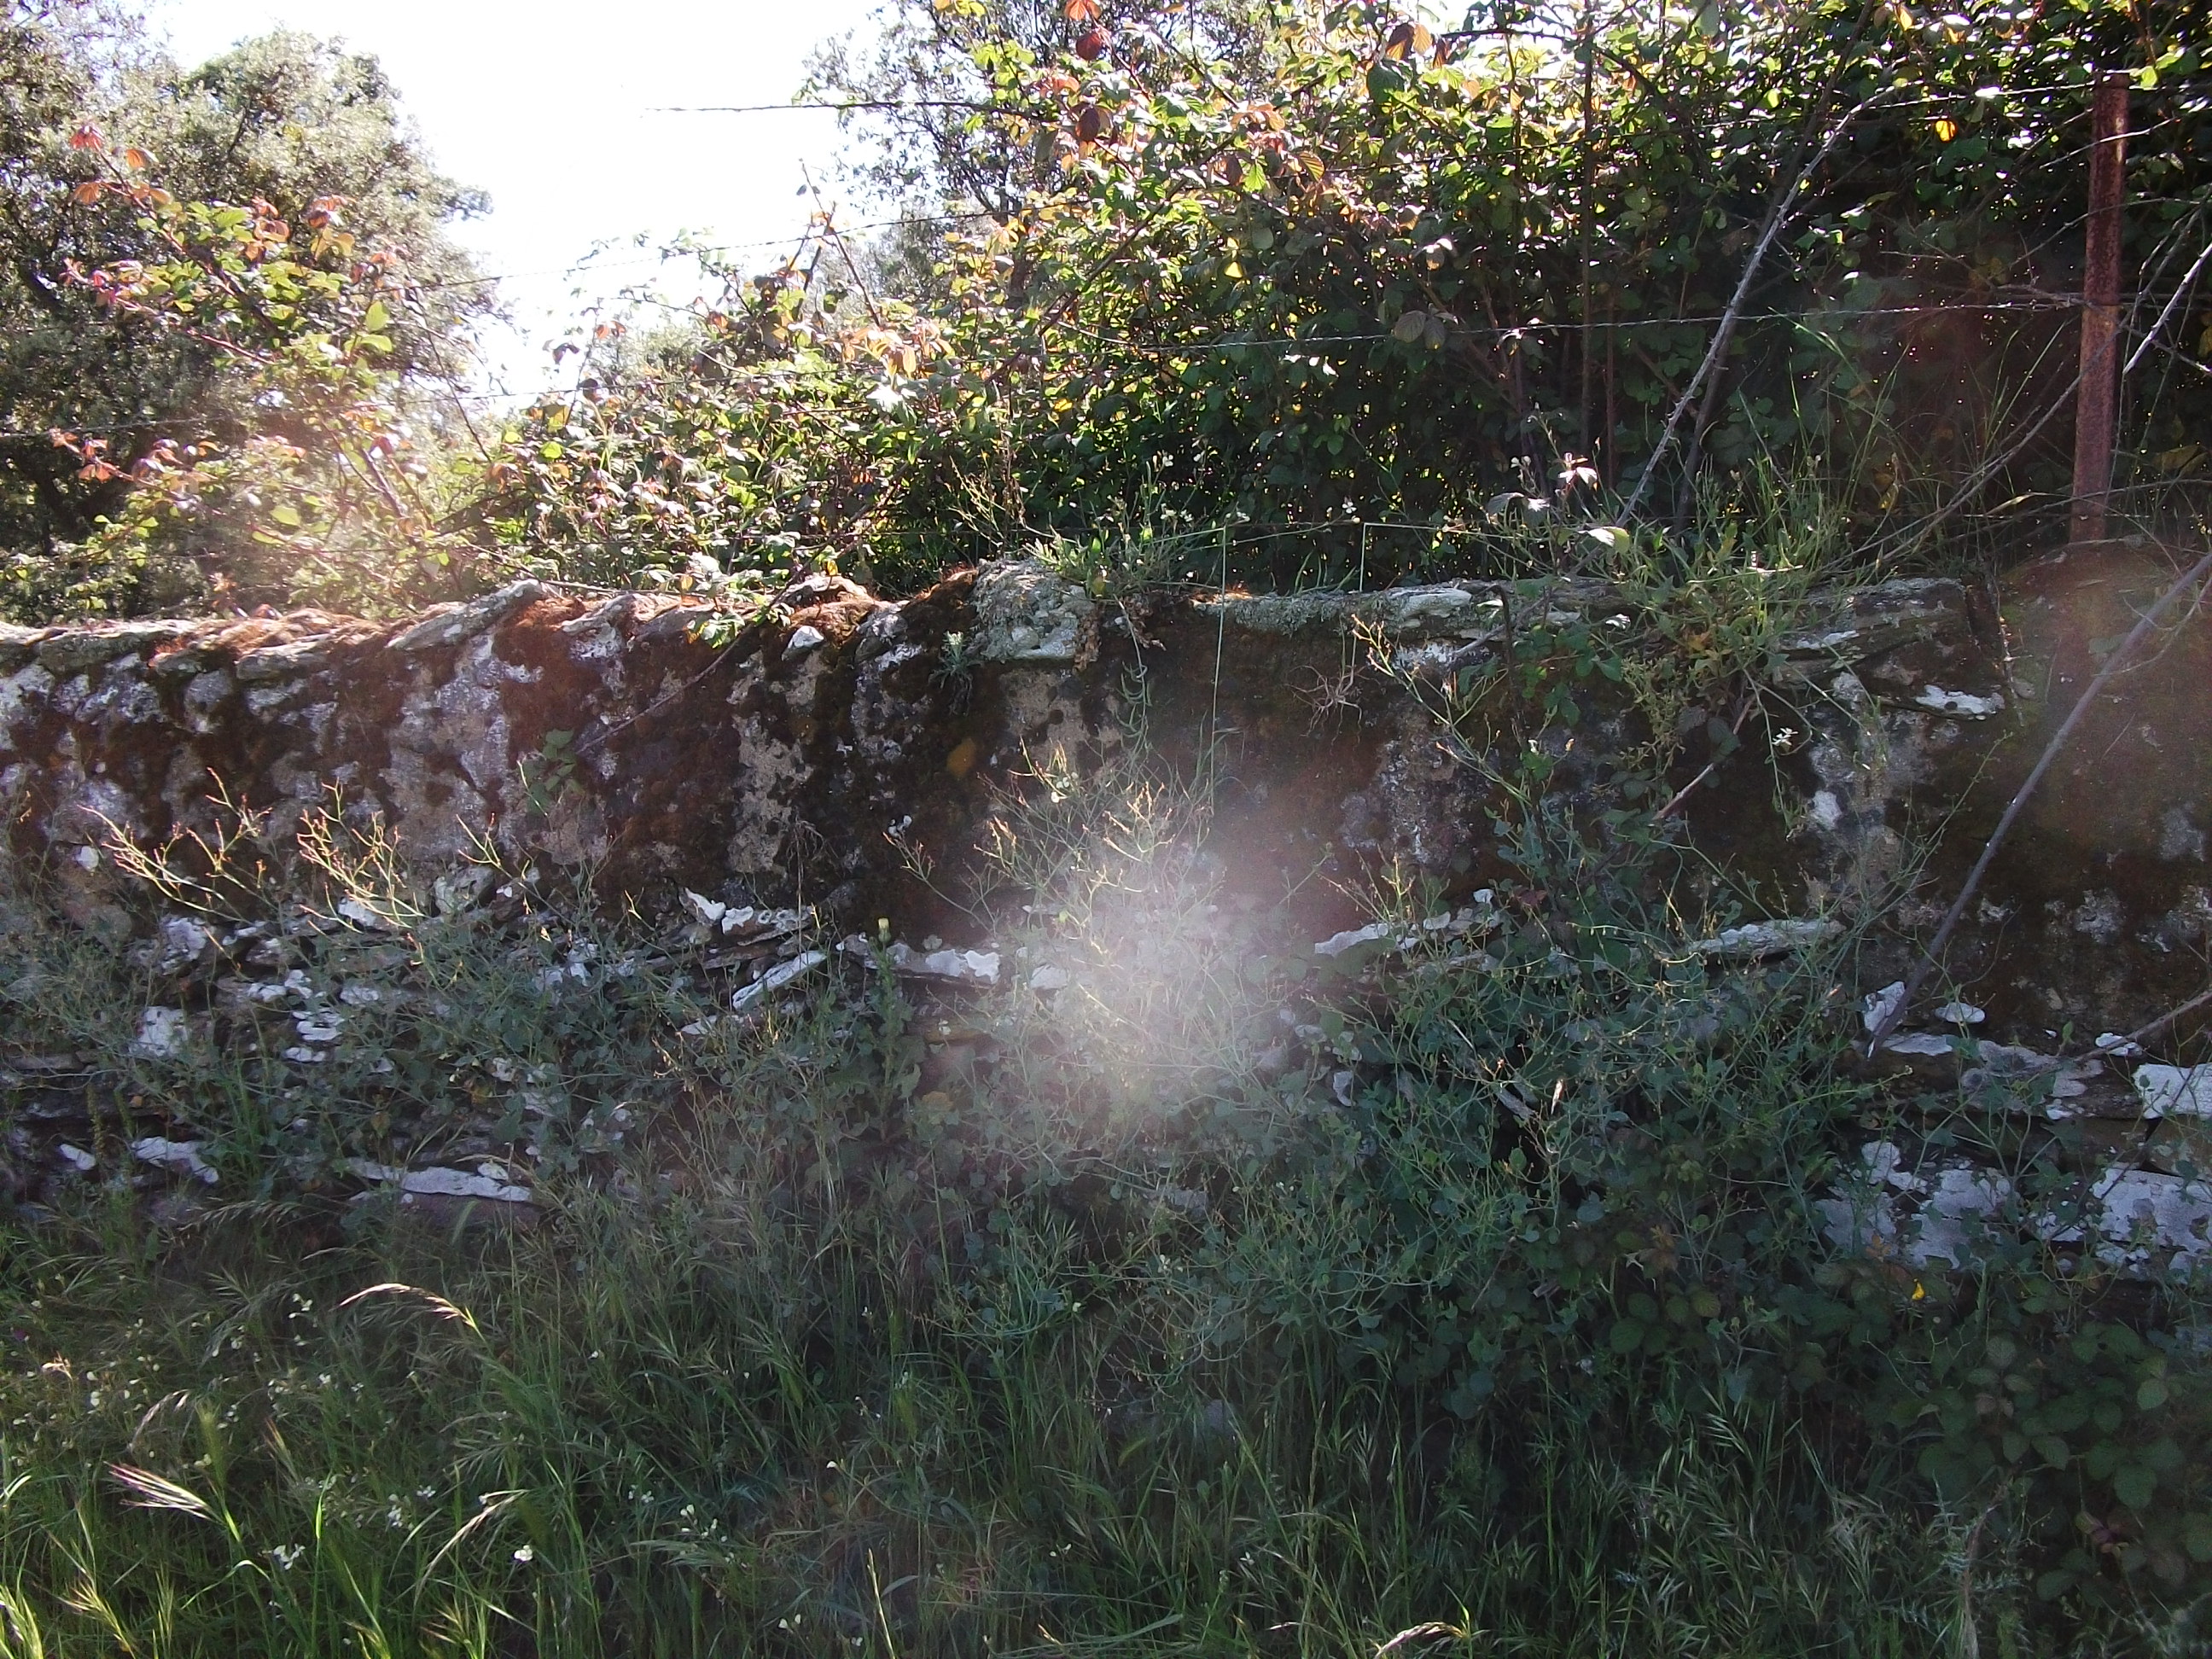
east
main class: Grassland
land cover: Grassland without tree/shrub cover
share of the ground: > 75 %
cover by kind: herbaceous plants 100 %
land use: Agriculture (excluding fallow land and kitchen gardens)
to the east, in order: Grassland without tree/shrub cover; Dry stone walls; Fences; Single bushes/trees; Broadleaved woodland
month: April
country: ES
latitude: 38.1661
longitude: -6.7738
